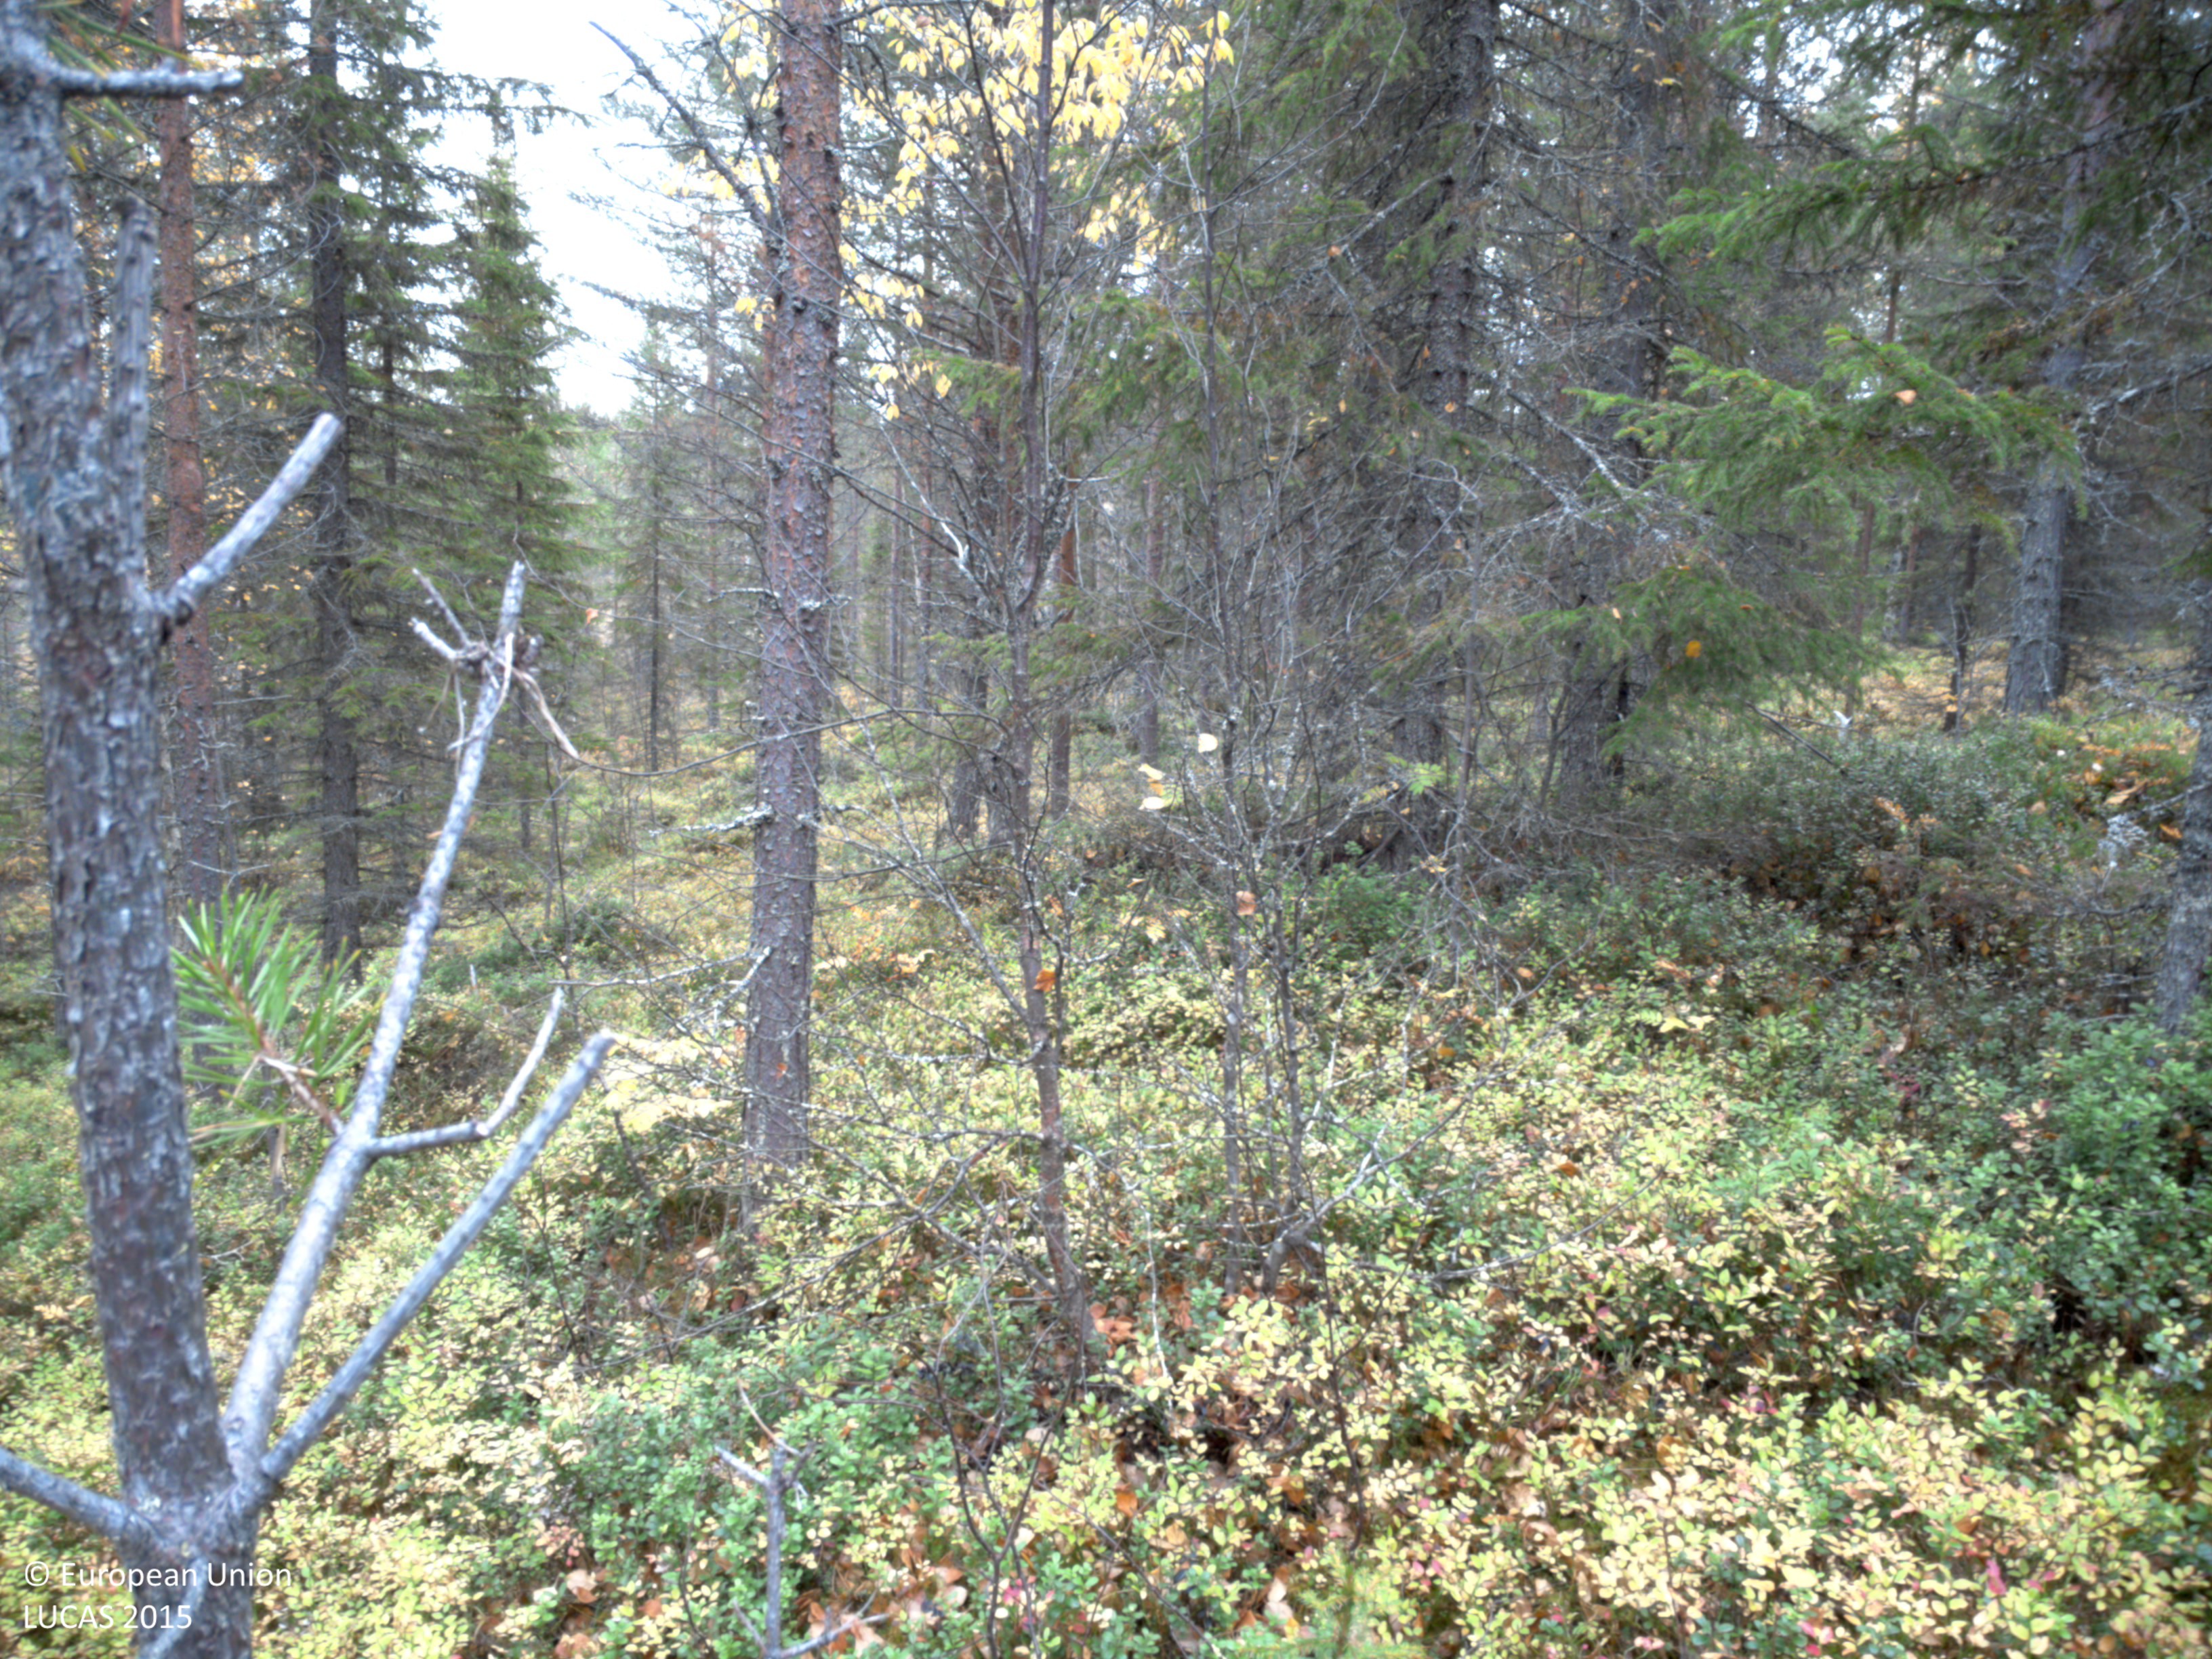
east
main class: Woodland
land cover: Other coniferous woodland
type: boreal forest
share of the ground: > 75 %
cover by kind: coniferous forest trees 75 %, shrubs 15 %, herbaceous plants 5 %, lichens and mosses 5 %
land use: Forestry
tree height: > 5 m
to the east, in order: Other coniferous woodland; Pine dominated coniferous woodland; Peatbogs; Pine dominated coniferous woodland; Other coniferous woodland
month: October
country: SE
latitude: 65.0125
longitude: 18.3870
